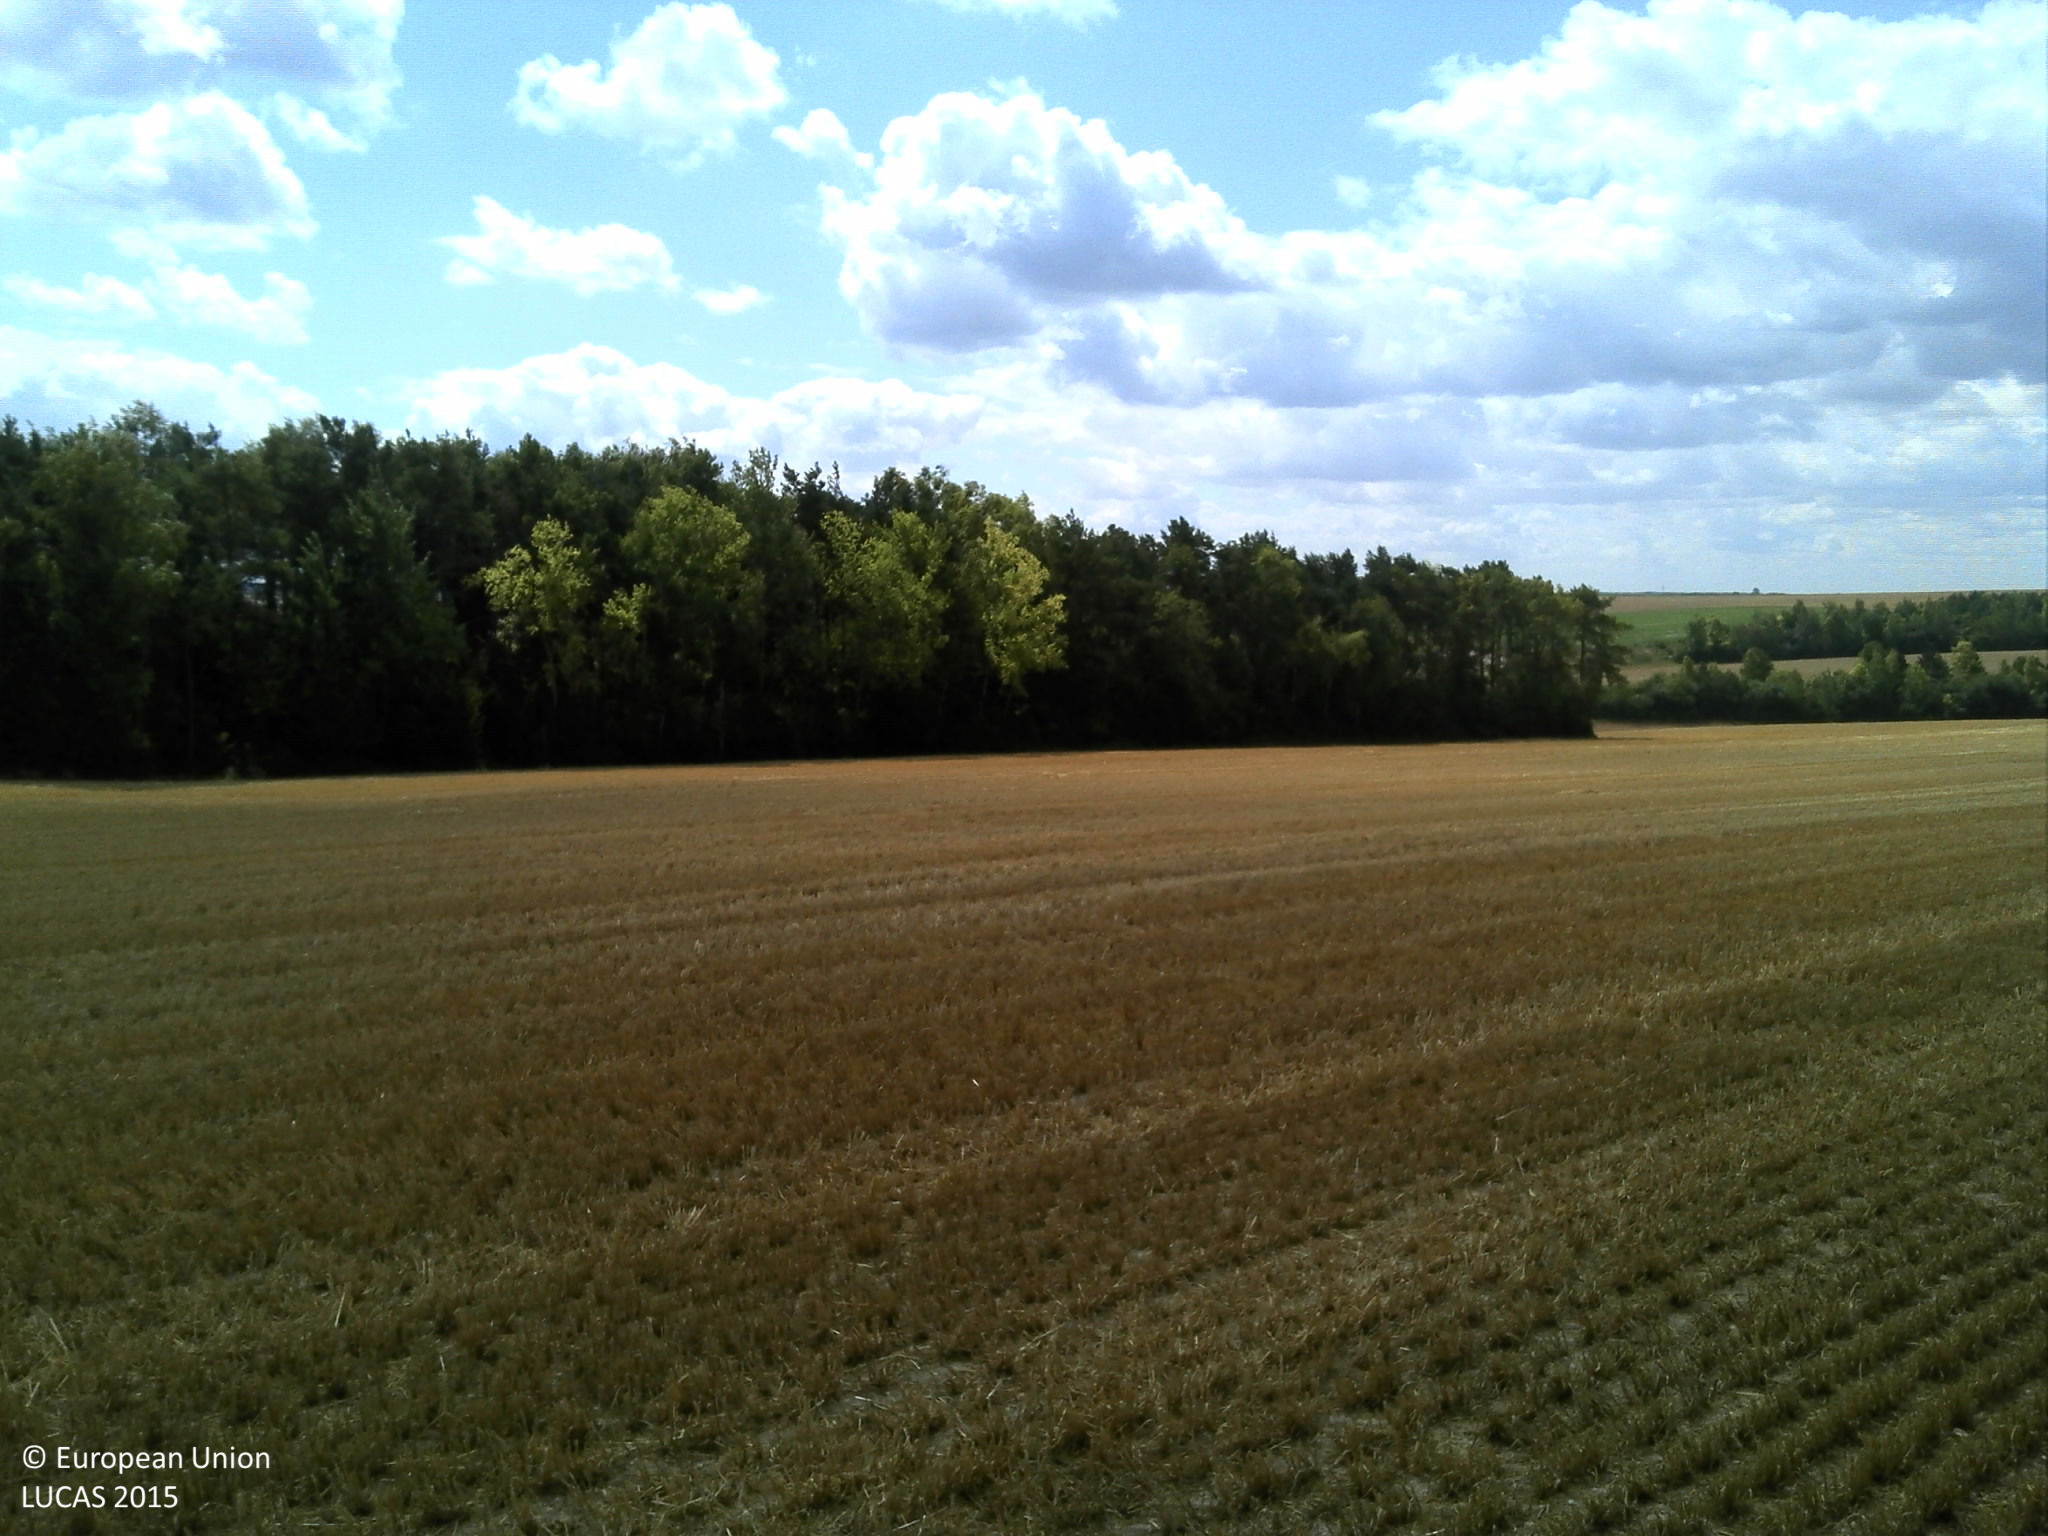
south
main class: Cropland
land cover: Barley
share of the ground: 50 - 75 %
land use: Agriculture (excluding fallow land and kitchen gardens)
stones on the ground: < 10 %
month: July
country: FR
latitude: 49.3002
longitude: 4.6197
